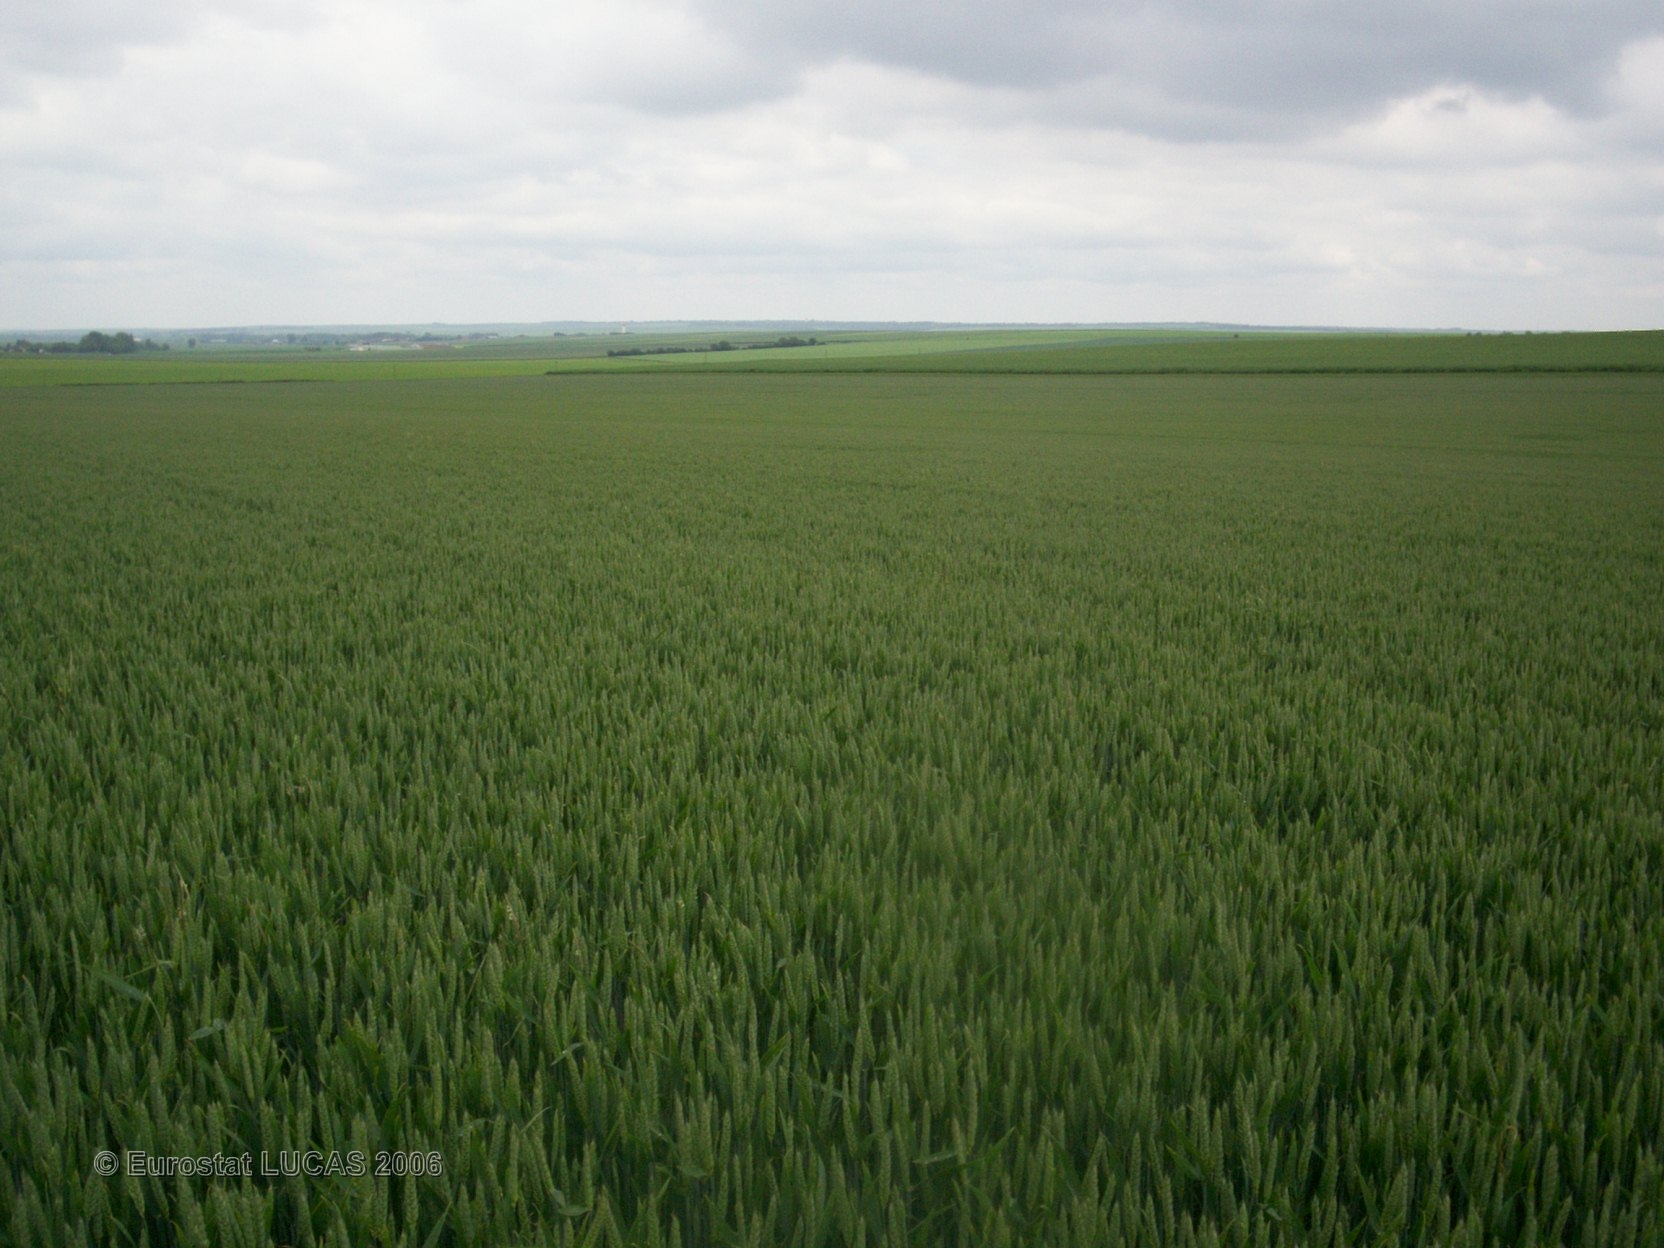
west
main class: Cropland
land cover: Common wheat
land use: Agriculture (excluding fallow land and kitchen gardens)
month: June
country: FR
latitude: 48.5889
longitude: 4.4520
